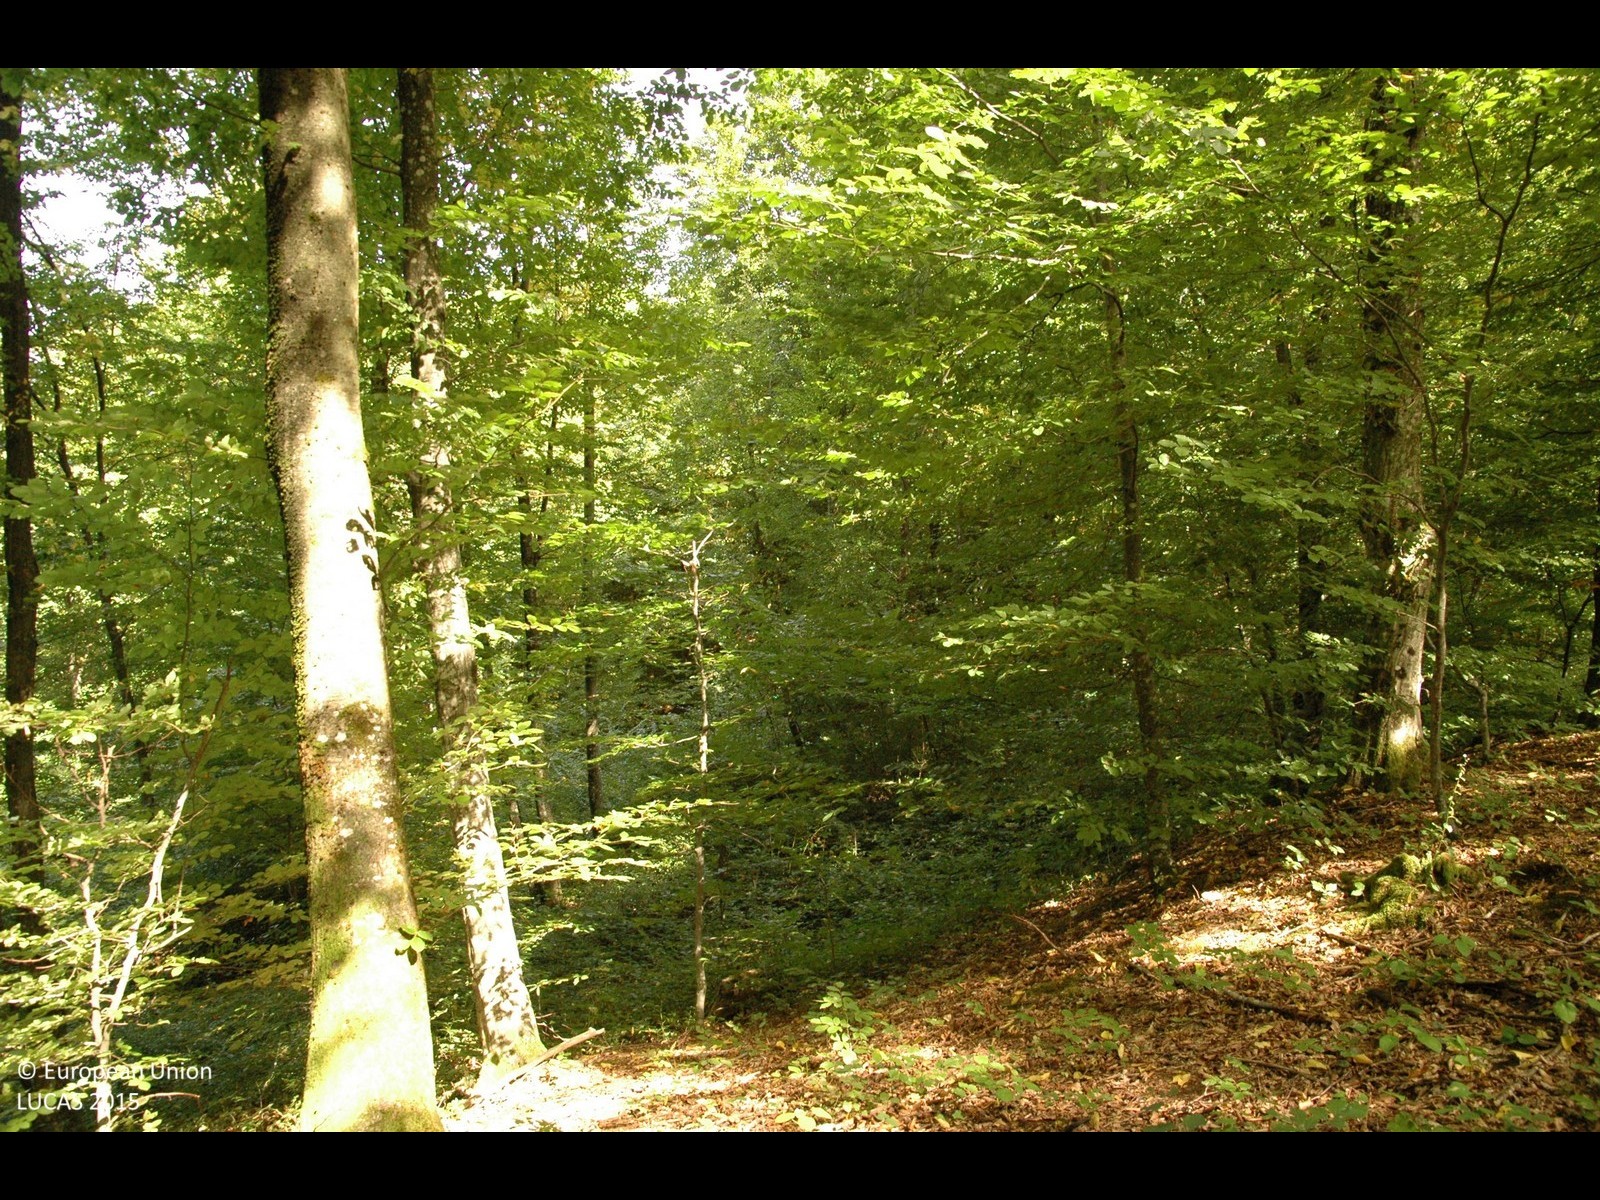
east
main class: Woodland
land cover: Broadleaved woodland
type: mesophytic deciduous forest
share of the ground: > 75 %
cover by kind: broadleaved forest trees 100 %
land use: Forestry
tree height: > 5 m
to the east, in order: Broadleaved woodland; Ditches and canals; Broadleaved woodland
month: September
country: HR
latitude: 45.5740
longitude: 15.9045
